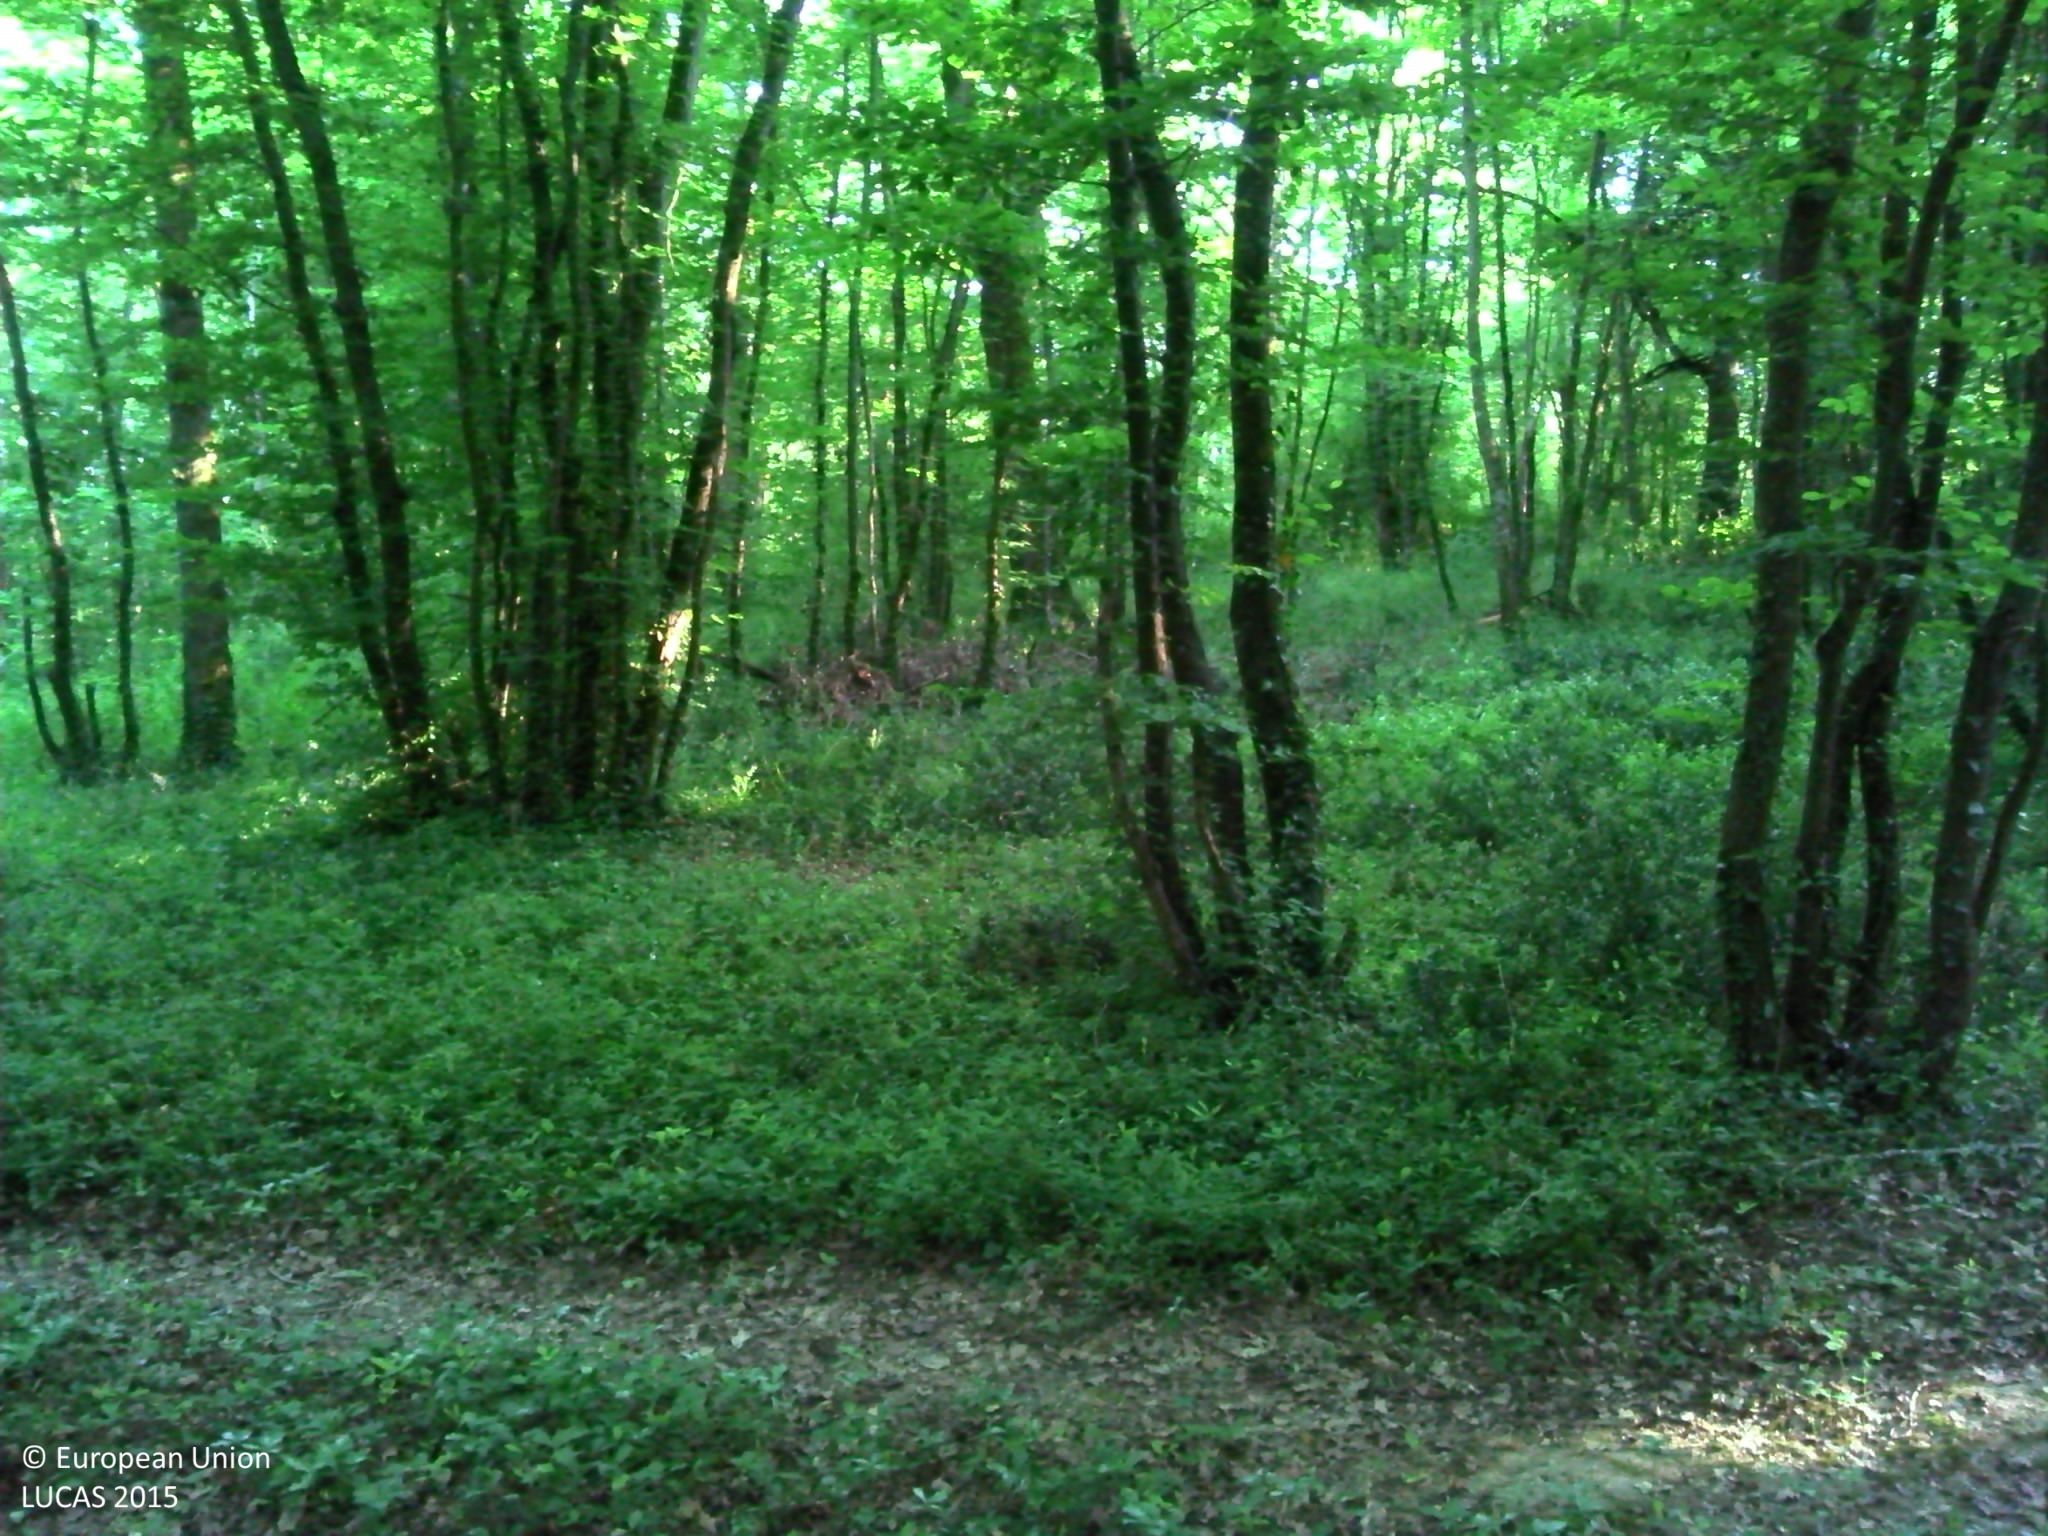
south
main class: Woodland
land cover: Broadleaved woodland
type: mesophytic deciduous forest
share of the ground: > 75 %
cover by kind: broadleaved forest trees 85 %, shrubs 10 %, herbaceous plants 5 %
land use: Forestry
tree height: > 5 m
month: June
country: FR
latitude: 43.6944
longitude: 0.6801
